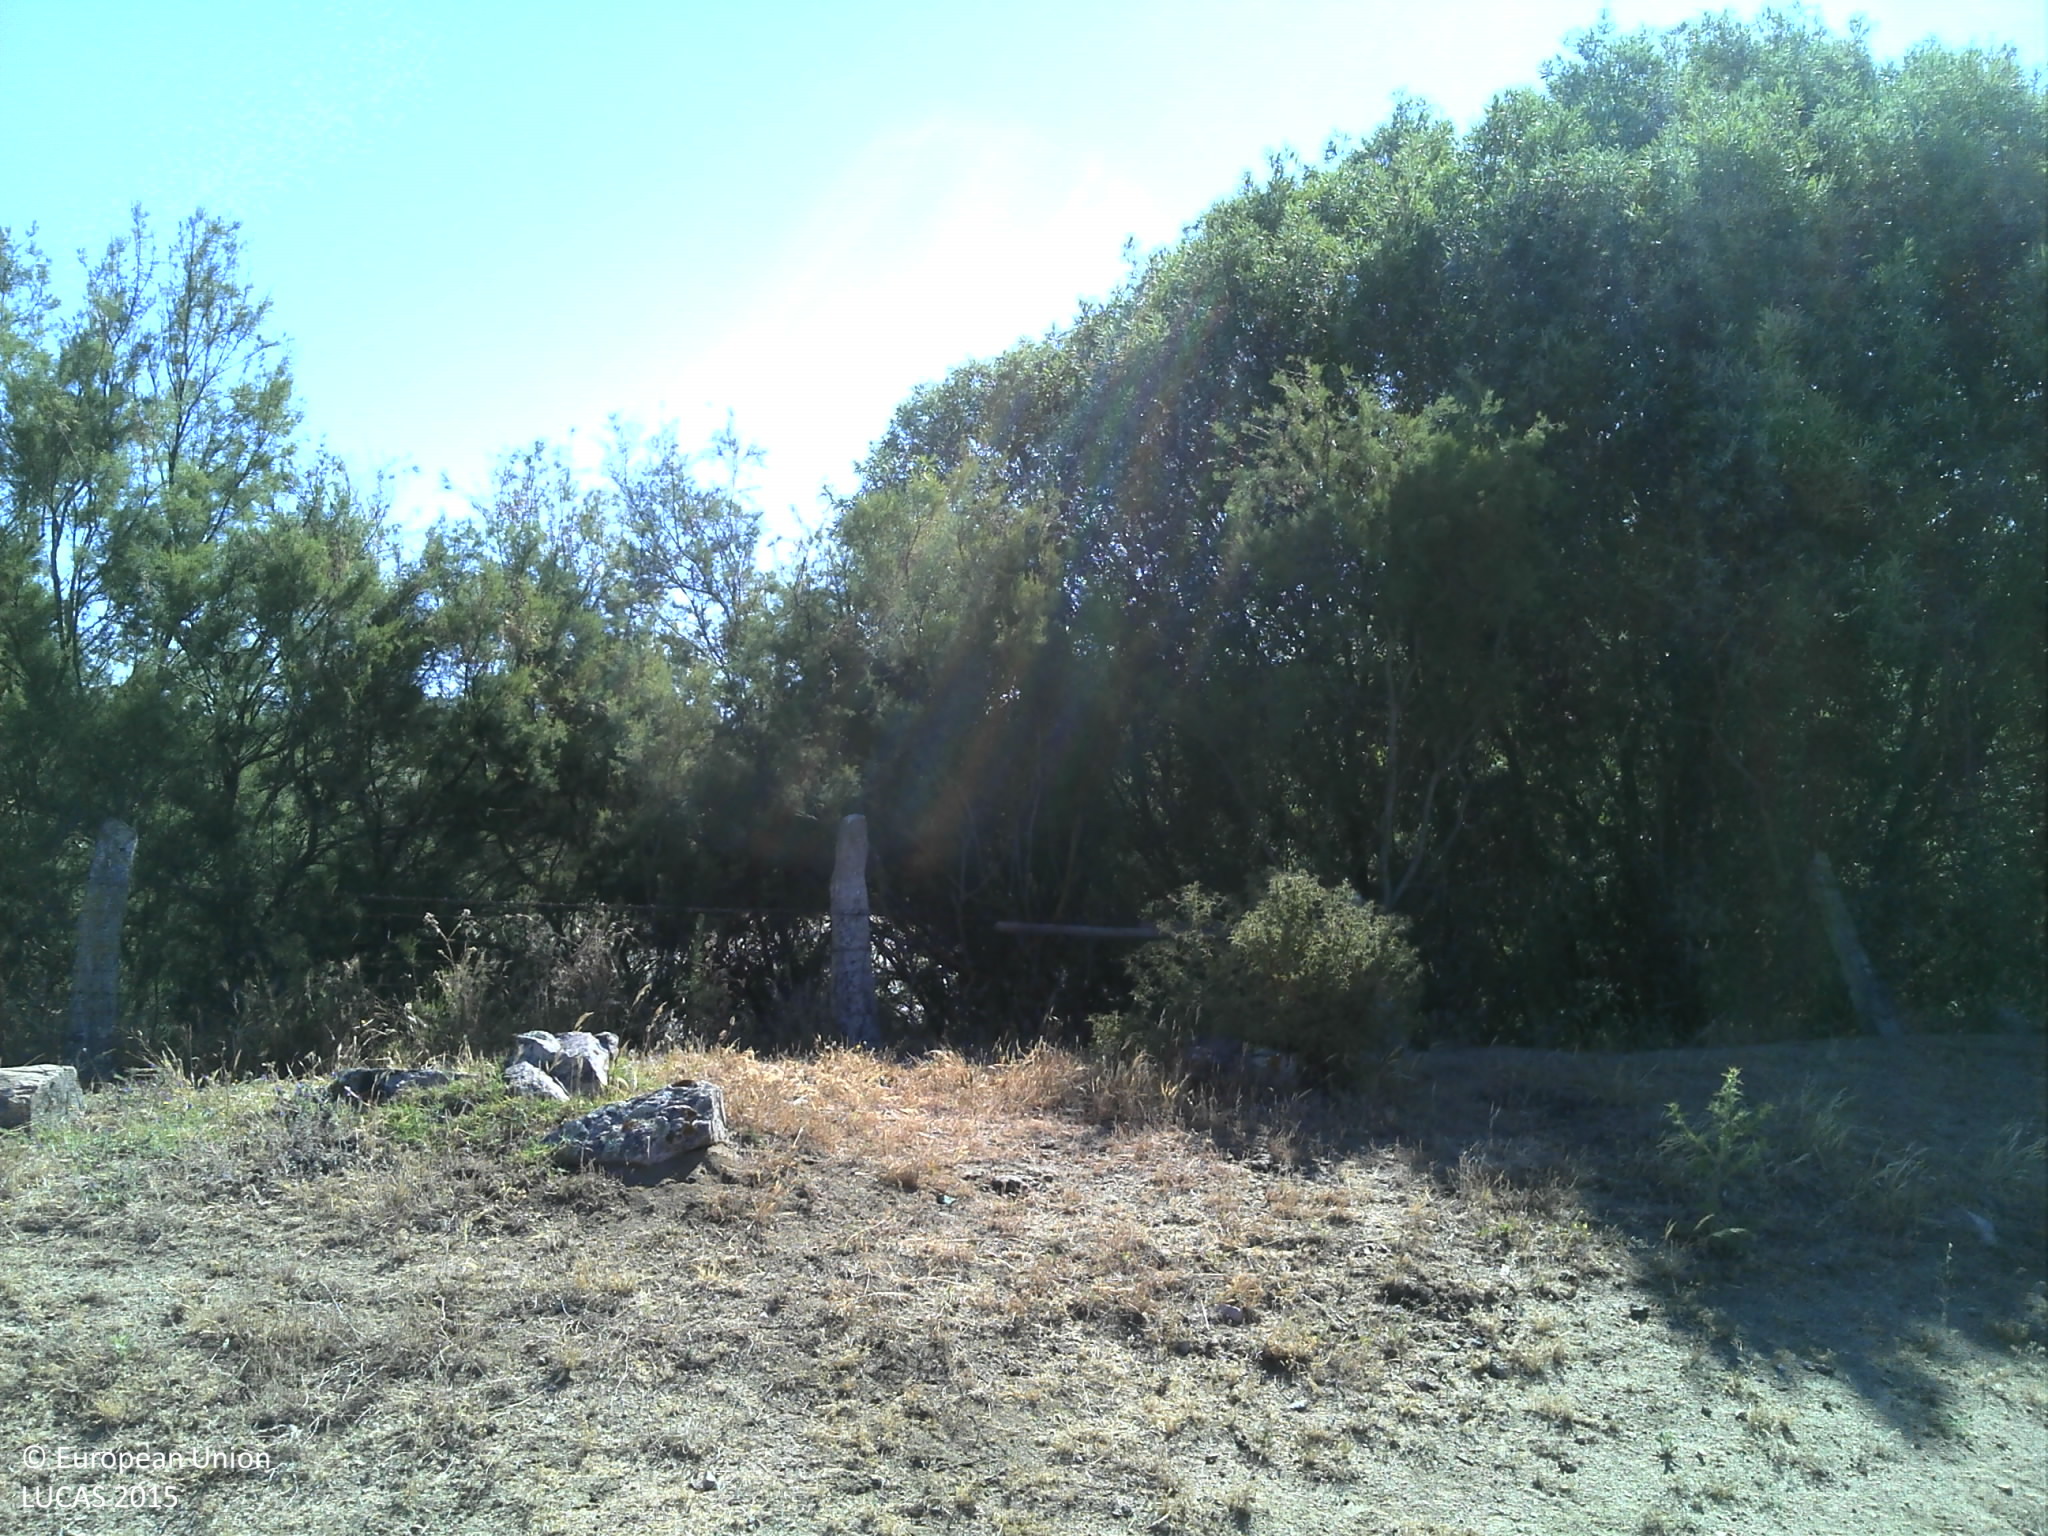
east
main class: Grassland
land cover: Grassland without tree/shrub cover
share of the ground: 25 - 50 %
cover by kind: unconsolidated bare surface 60 %, herbaceous plants 40 %
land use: Agriculture (excluding fallow land and kitchen gardens)
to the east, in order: Grassland without tree/shrub cover; Fences; Shrubland with sparse tree cover; Inland fresh water bodies; Shruby margins; Fences; Grassland with sparse tree/shrub cover; Ditches and canals; Broadleaved woodland; Fences; Tracks; Fences; Broadleaved woodland
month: June
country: PT
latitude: 38.7572
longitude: -8.1739
